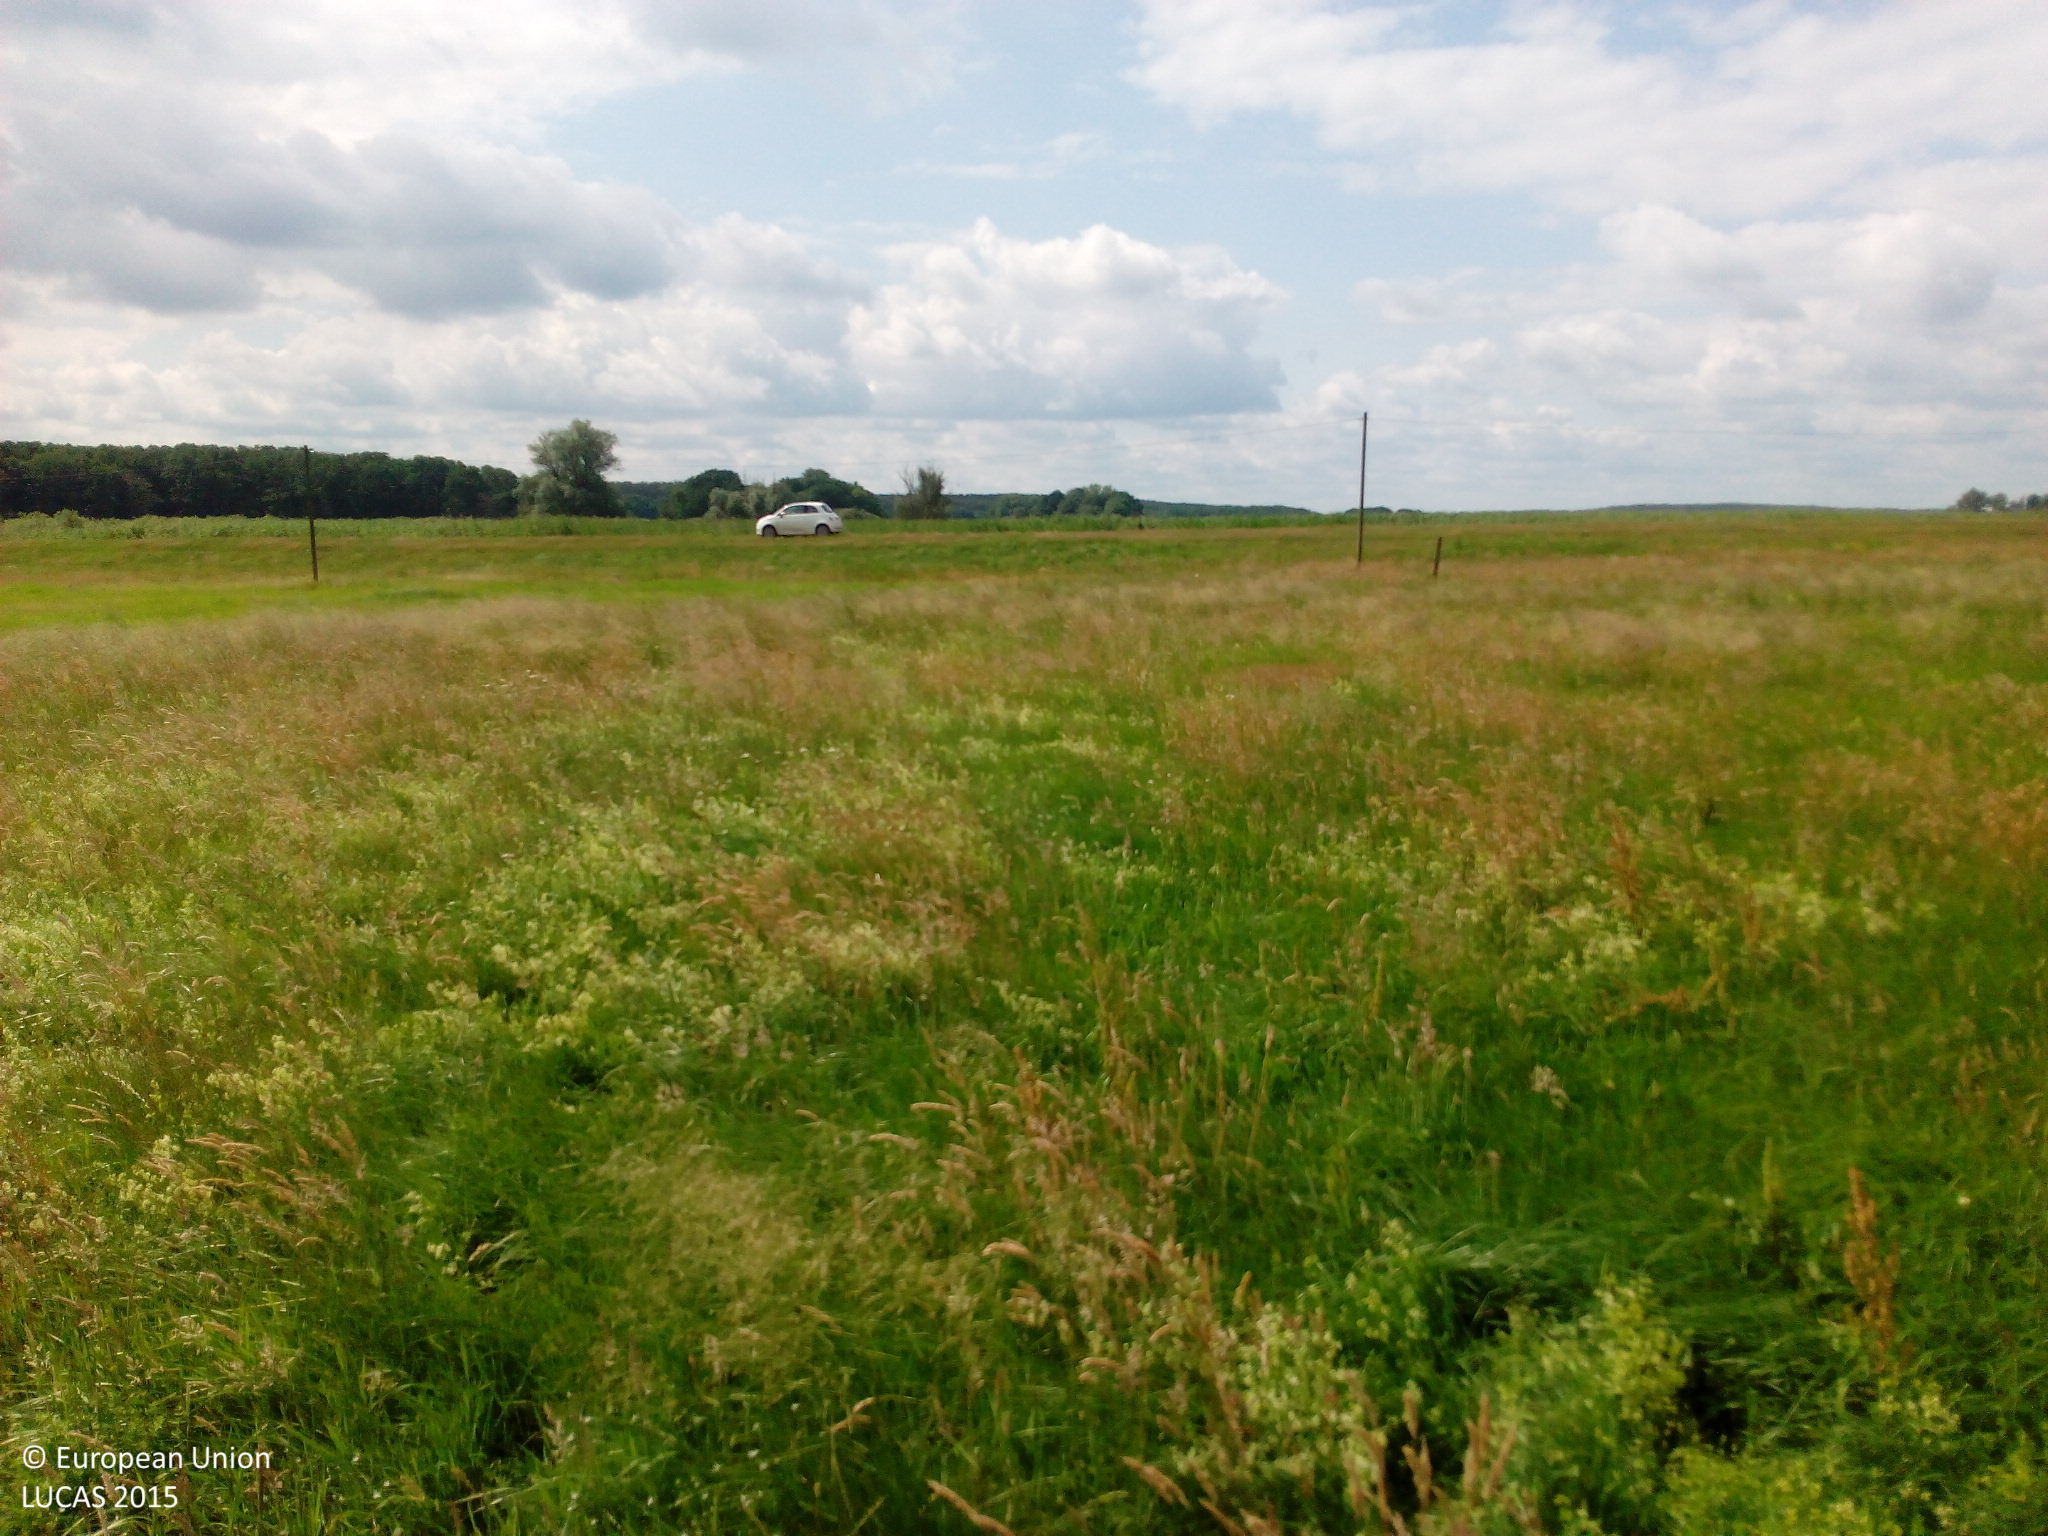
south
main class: Grassland
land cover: Grassland without tree/shrub cover
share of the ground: > 75 %
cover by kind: herbaceous plants 100 %
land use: Agriculture (excluding fallow land and kitchen gardens)
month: July
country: DE
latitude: 52.6941
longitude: 12.4409
